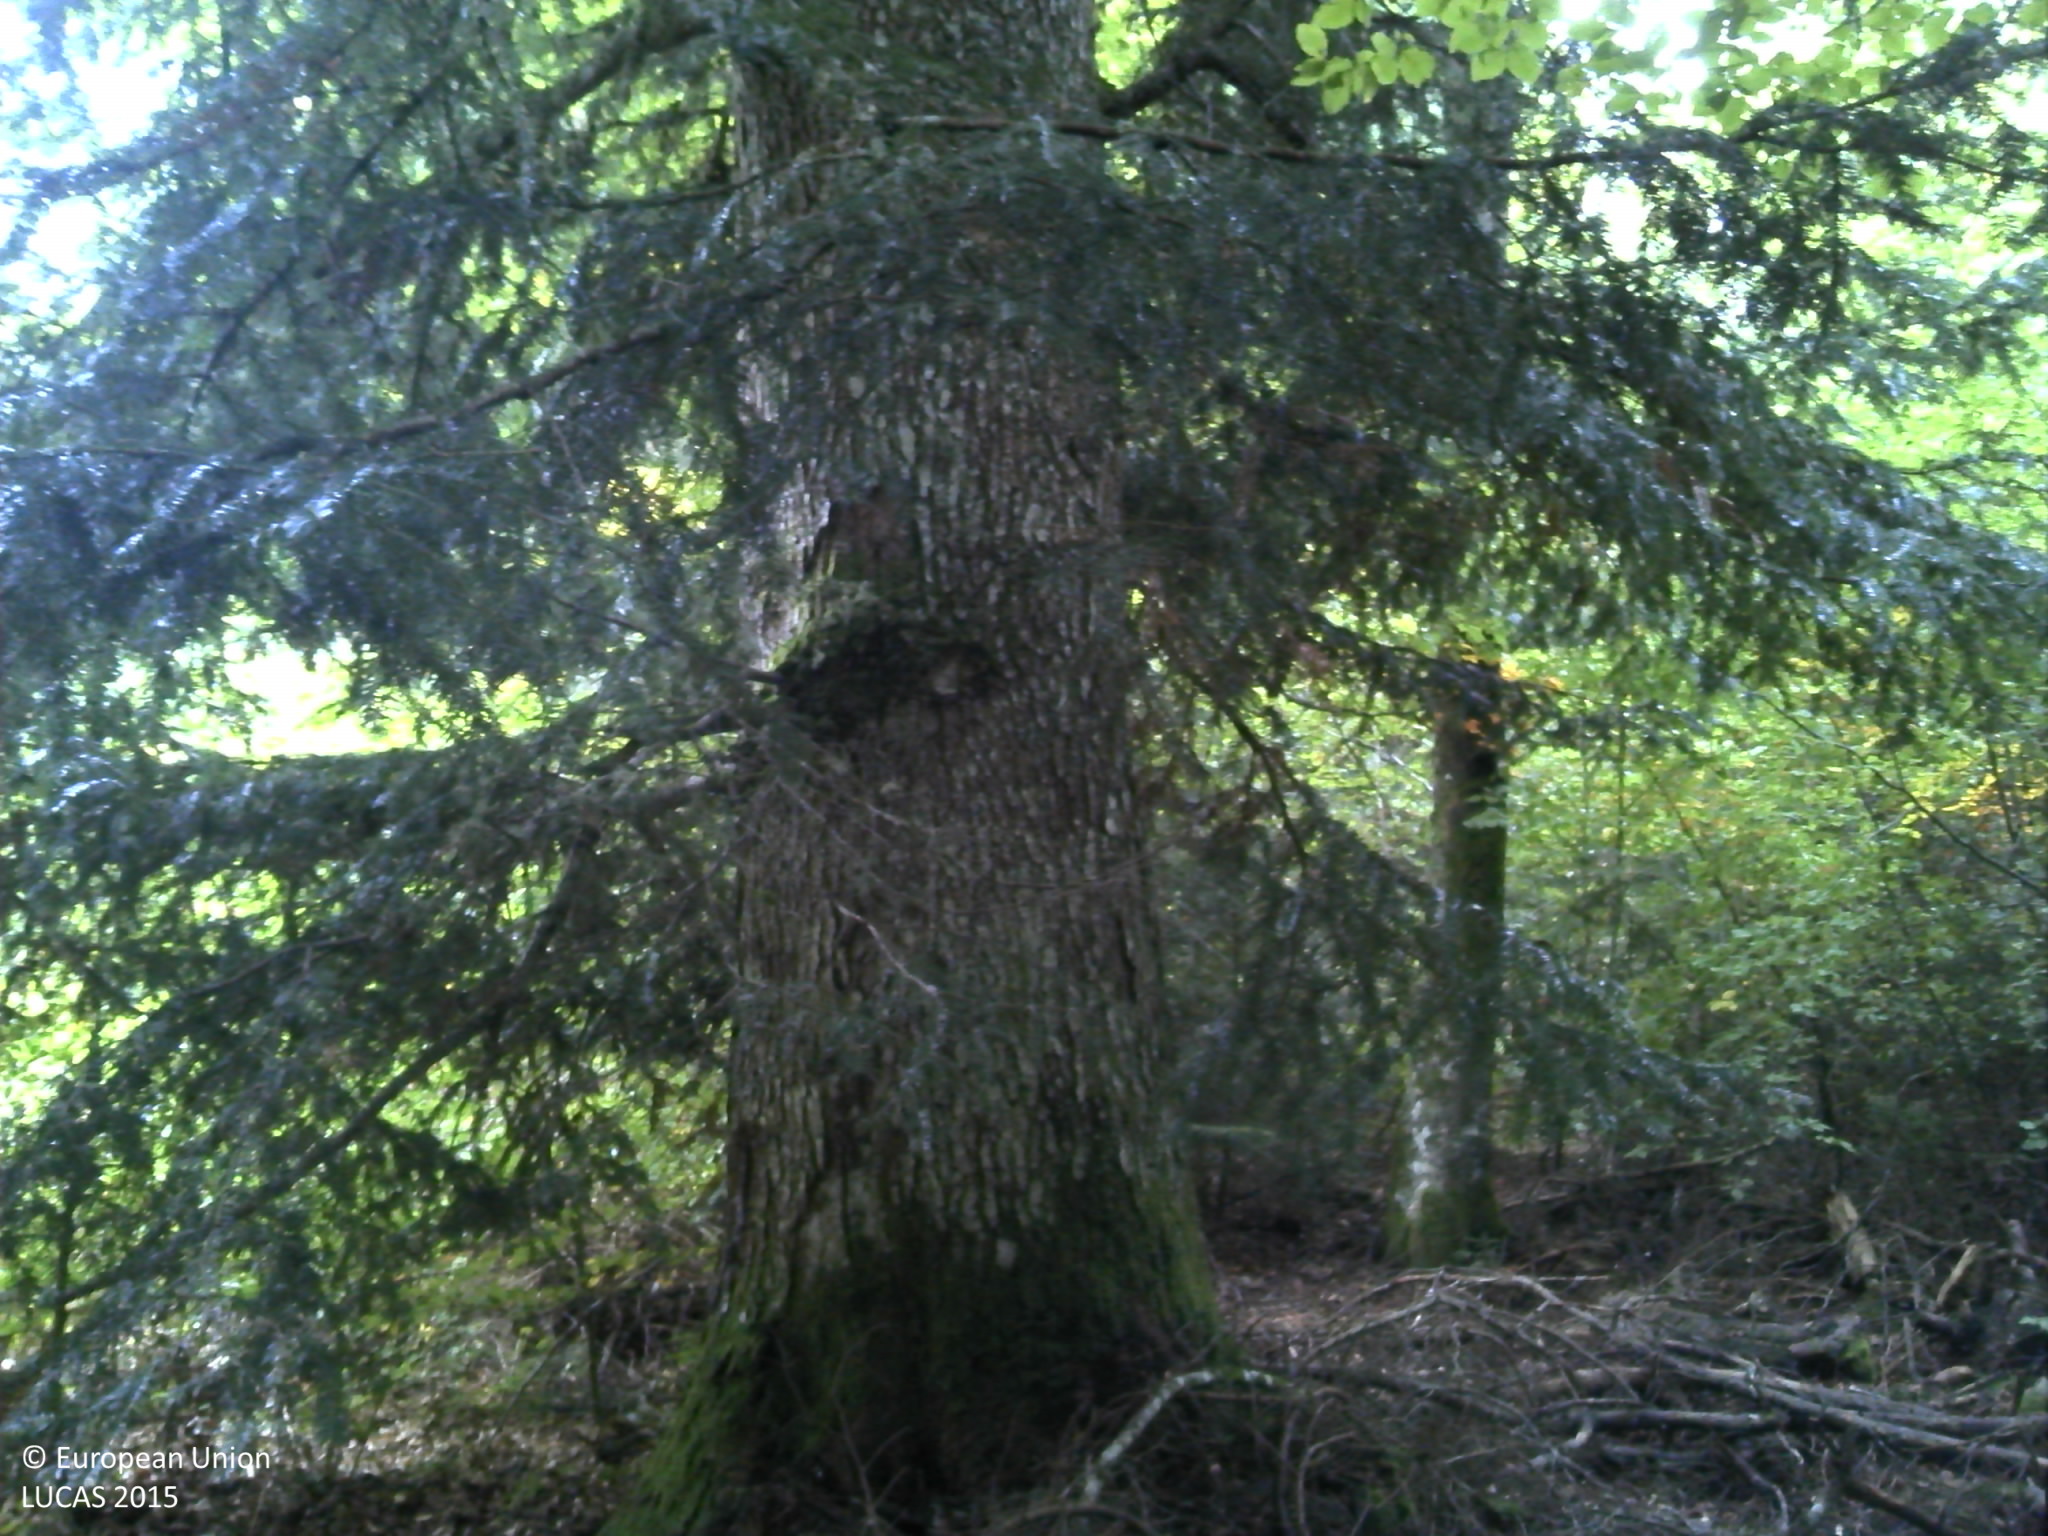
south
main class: Woodland
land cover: Spruce dominated mixed woodland
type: hemiboreal forest and nemoral coniferous forest and mixed broadleaved-coniferous forest
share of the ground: > 75 %
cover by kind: coniferous forest trees 60 %, broadleaved forest trees 30 %, lichens and mosses 10 %
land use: Forestry
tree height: > 5 m
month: September
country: FR
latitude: 45.5377
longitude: 2.9181
